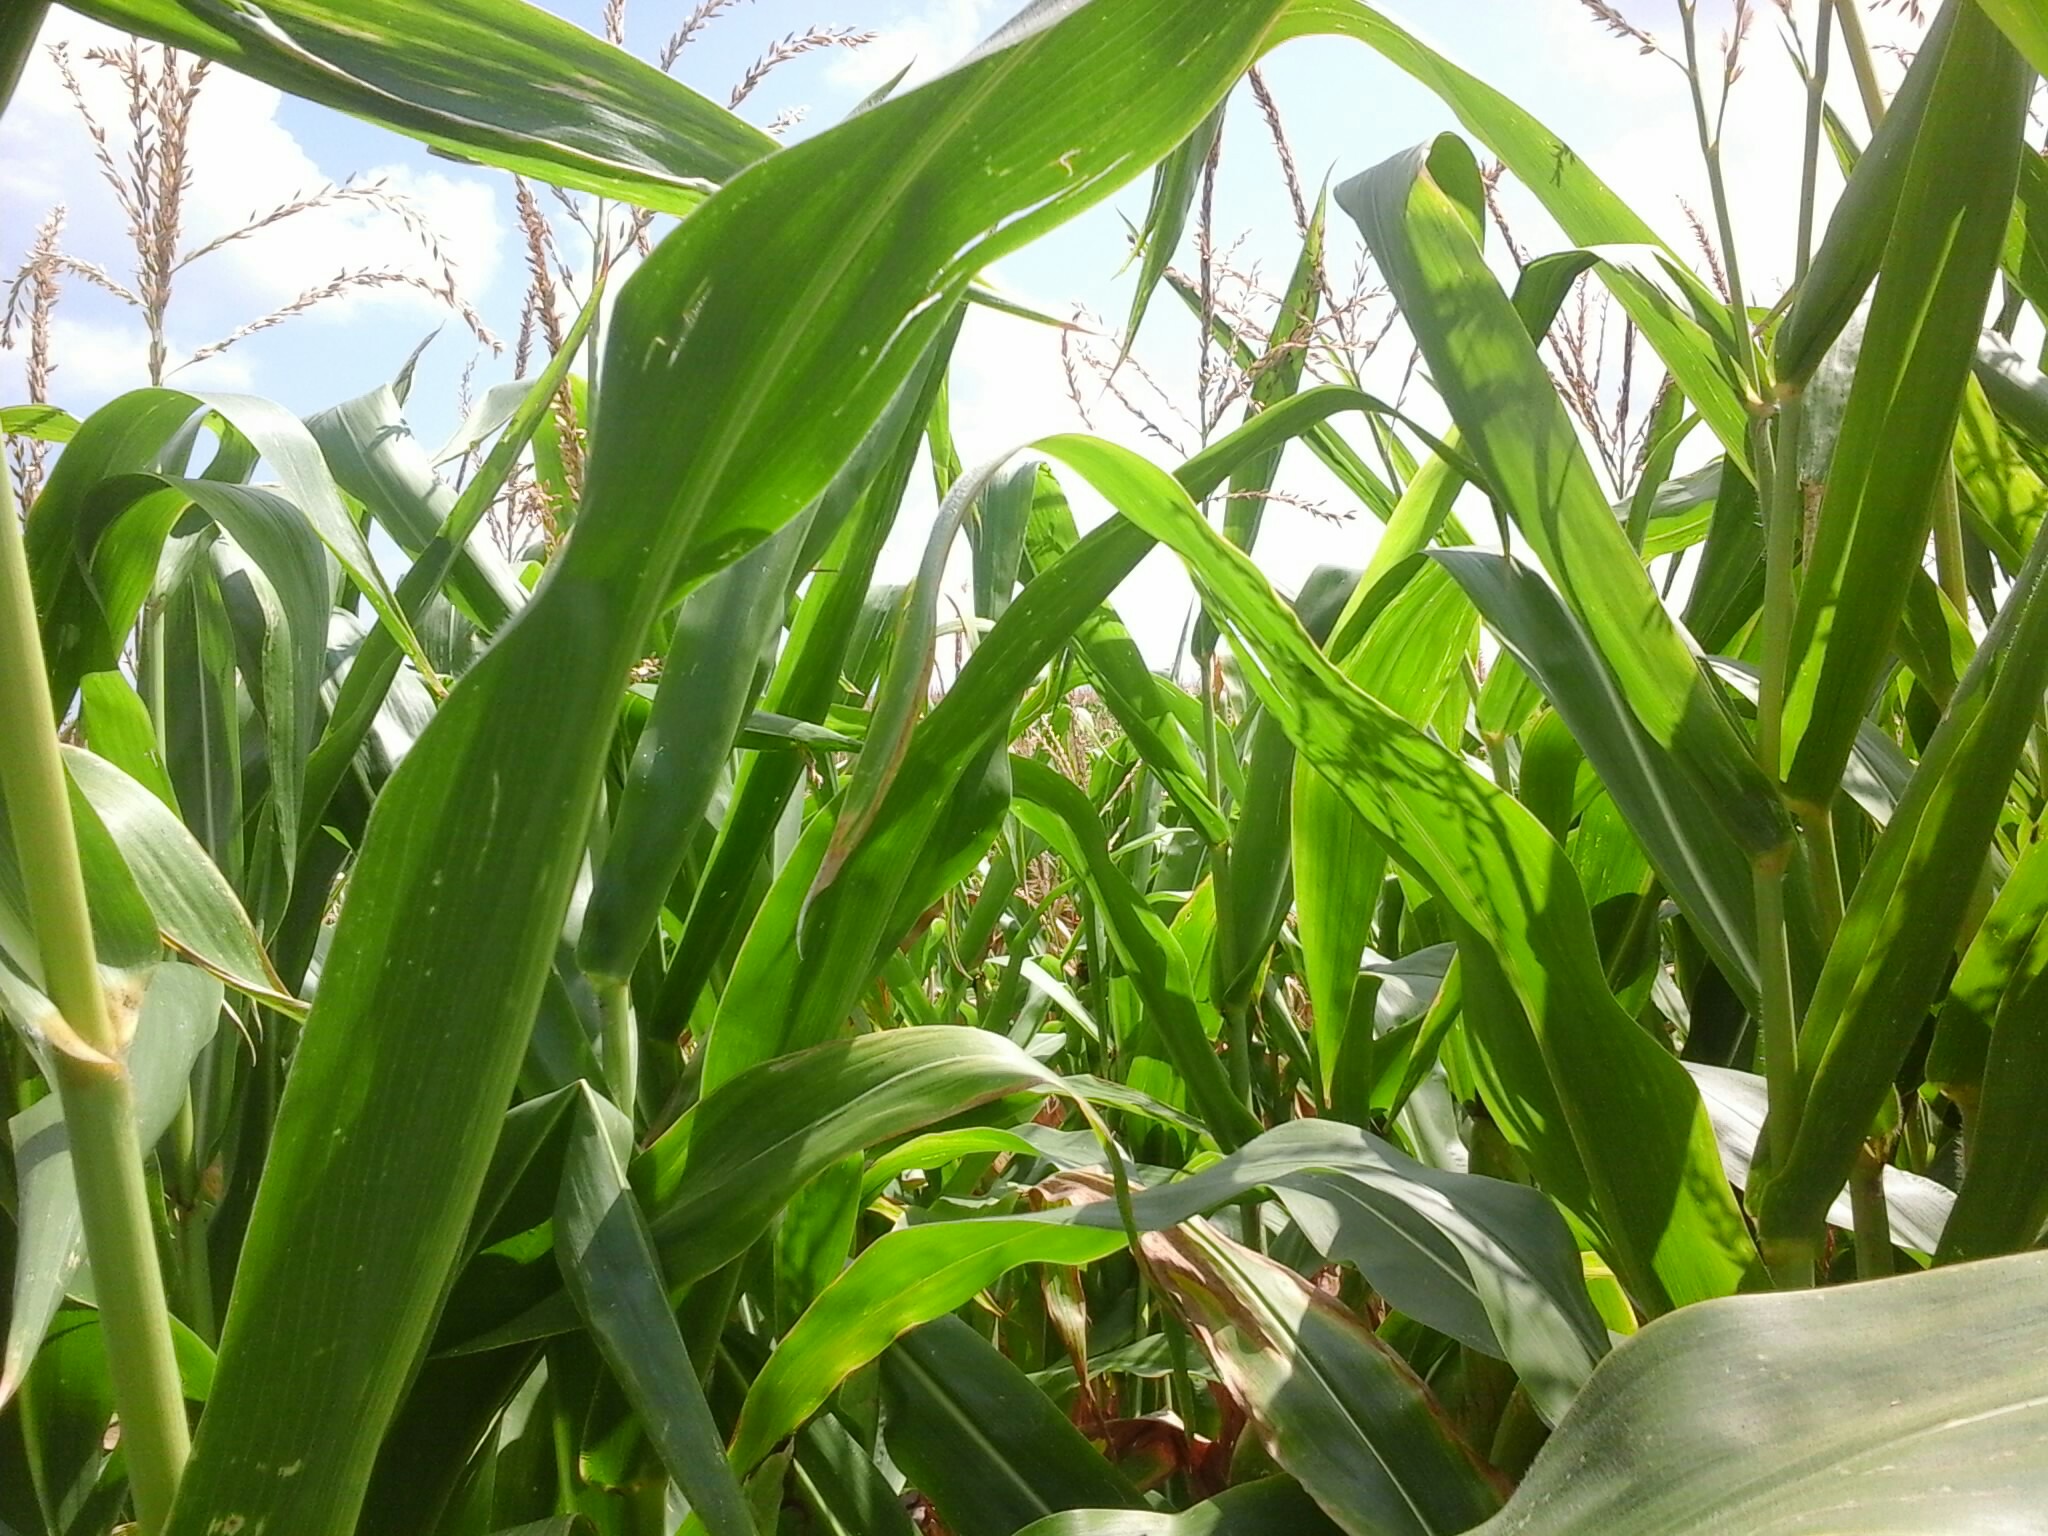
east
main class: Cropland
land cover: Maize
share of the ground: > 75 %
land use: Agriculture (excluding fallow land and kitchen gardens)
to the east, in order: Maize
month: August
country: HU
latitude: 47.6206
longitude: 18.3024
